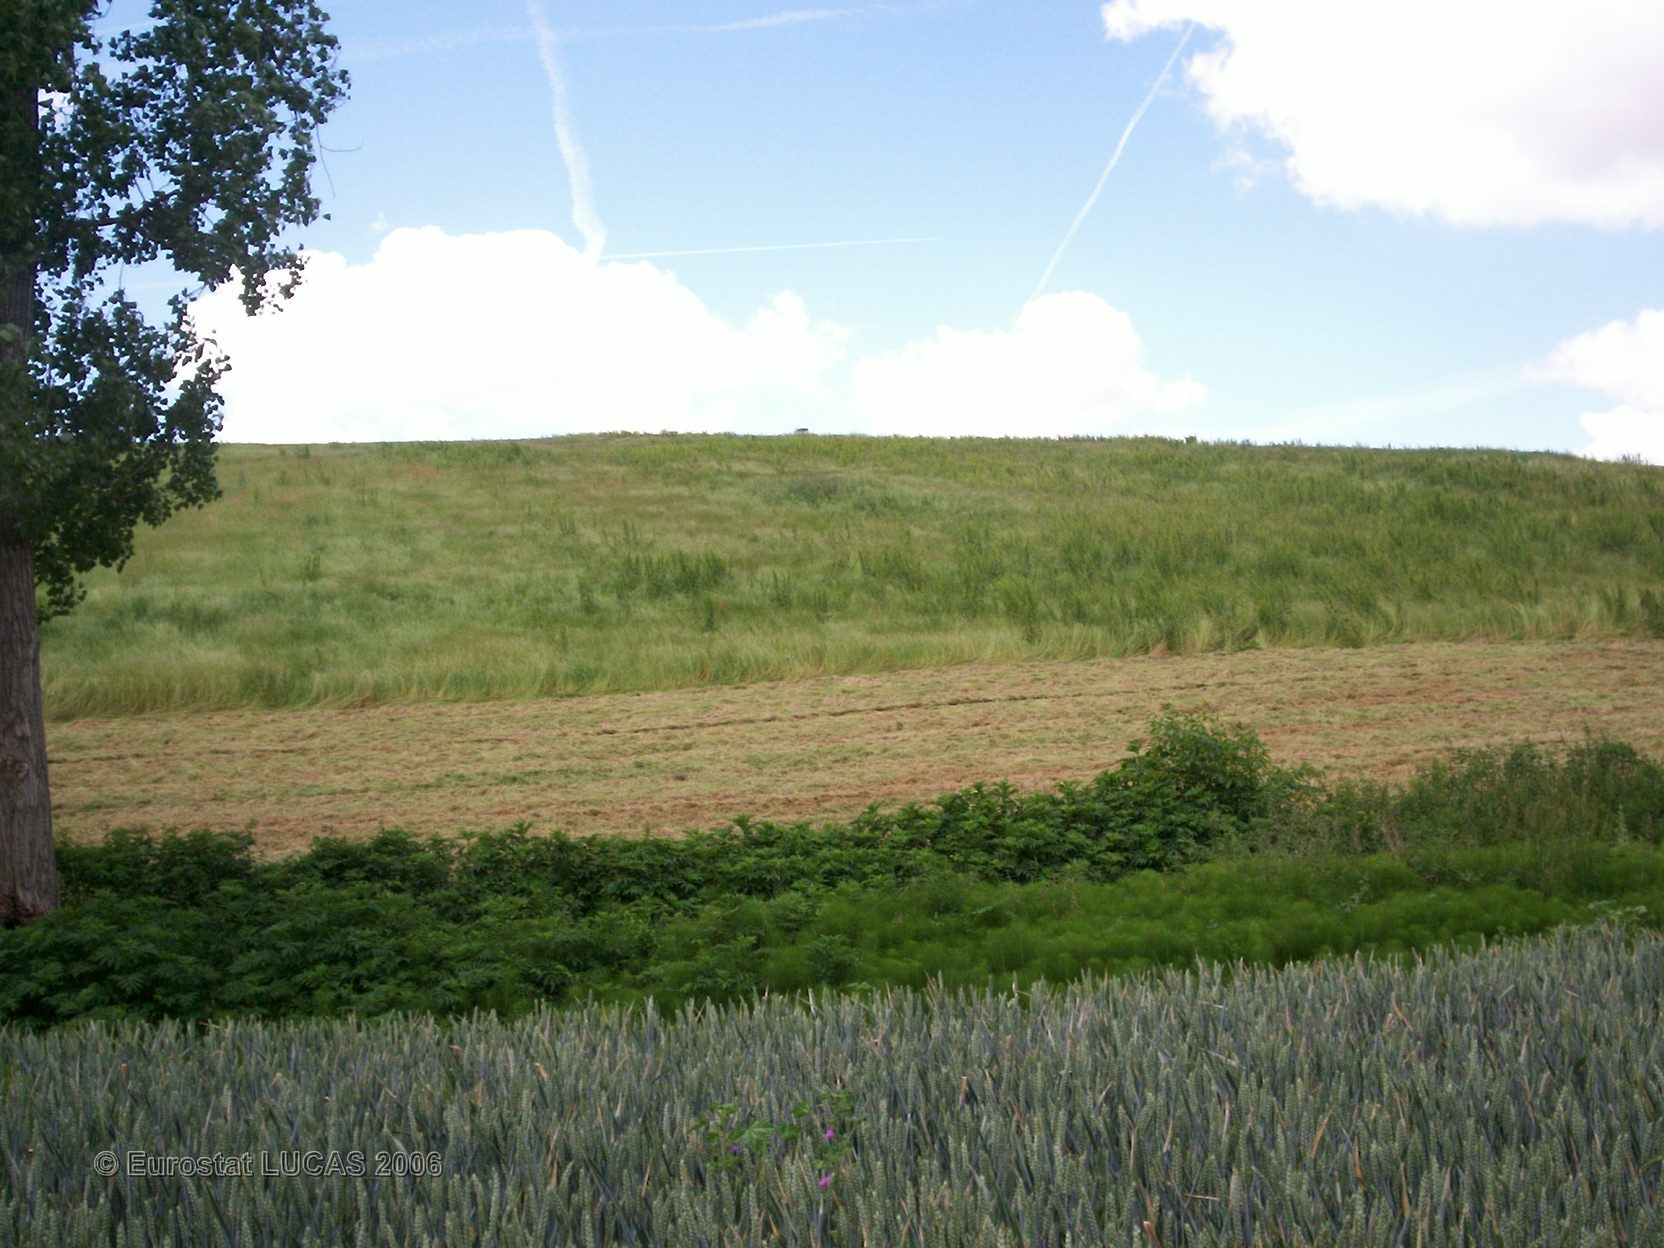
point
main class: Grassland
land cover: Grassland without tree/shrub cover
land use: Agriculture (excluding fallow land and kitchen gardens)
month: May
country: FR
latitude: 43.5039
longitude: 0.9844
